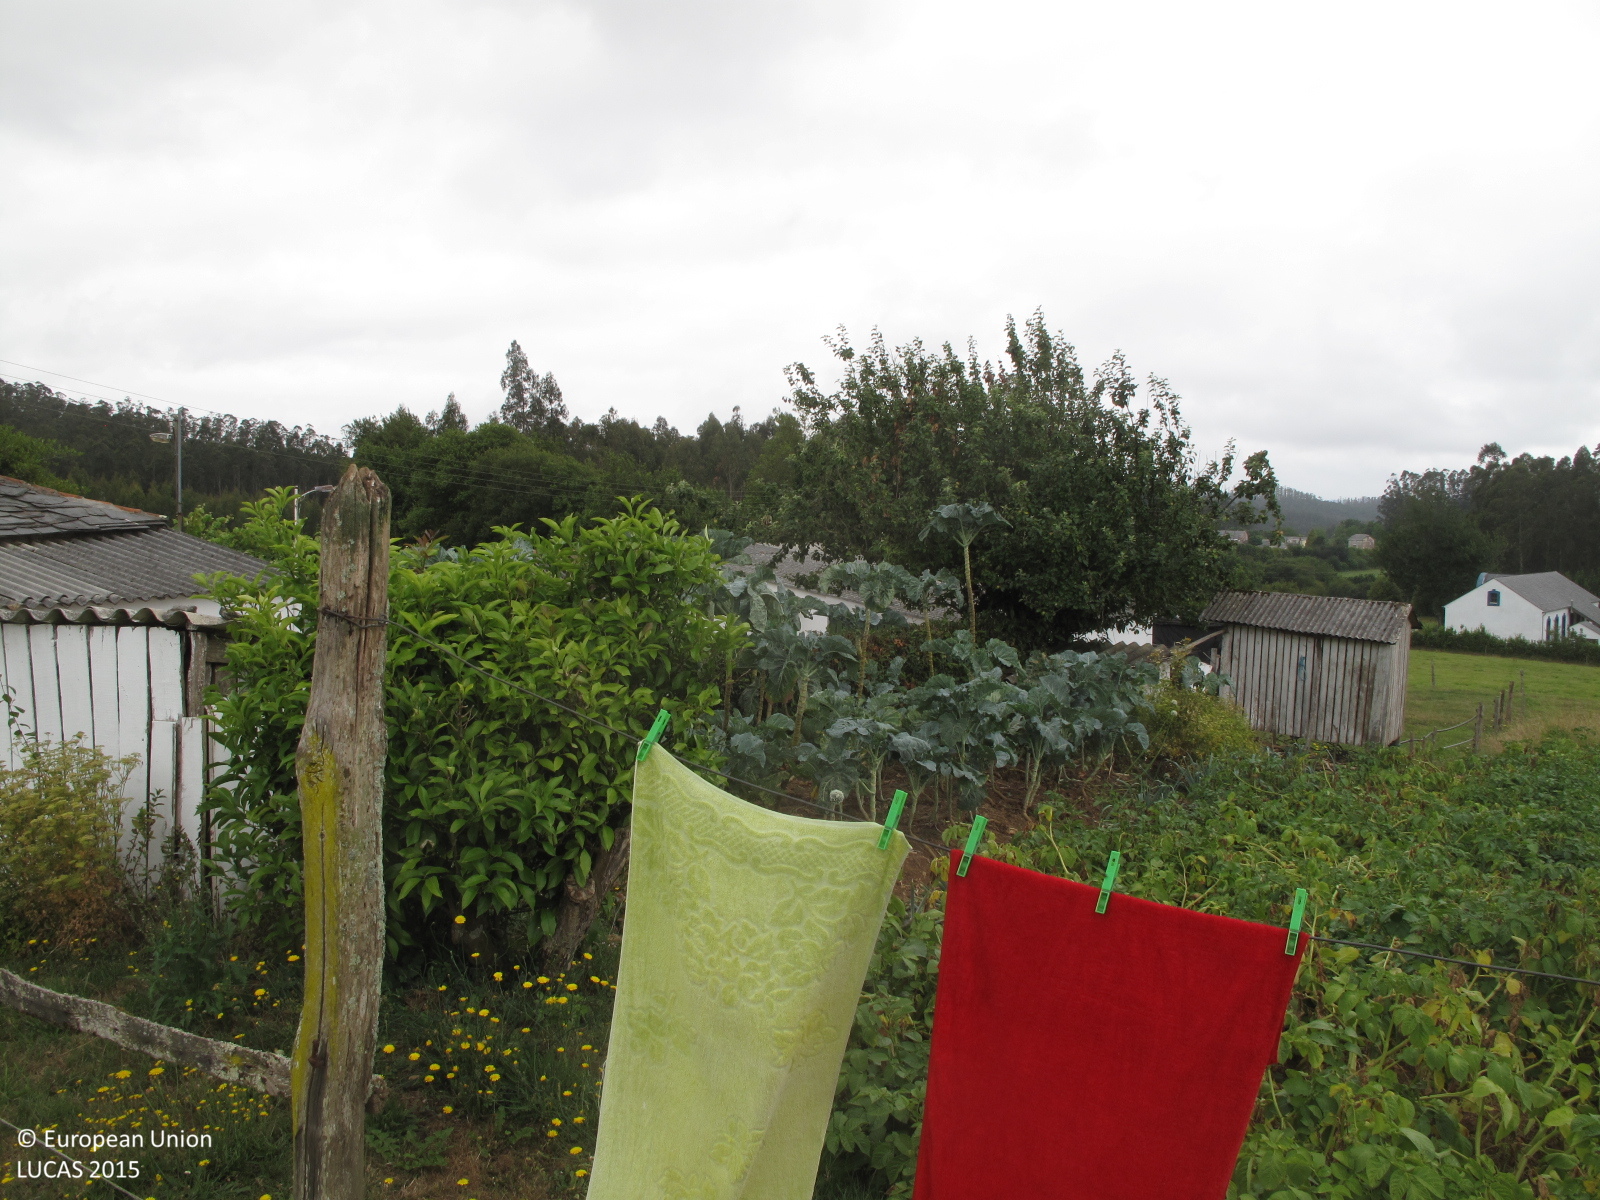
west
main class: Grassland
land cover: Grassland without tree/shrub cover
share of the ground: > 75 %
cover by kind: herbaceous plants 100 %
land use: Agriculture (excluding fallow land and kitchen gardens)
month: July
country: ES
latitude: 43.6129
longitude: -7.8742
